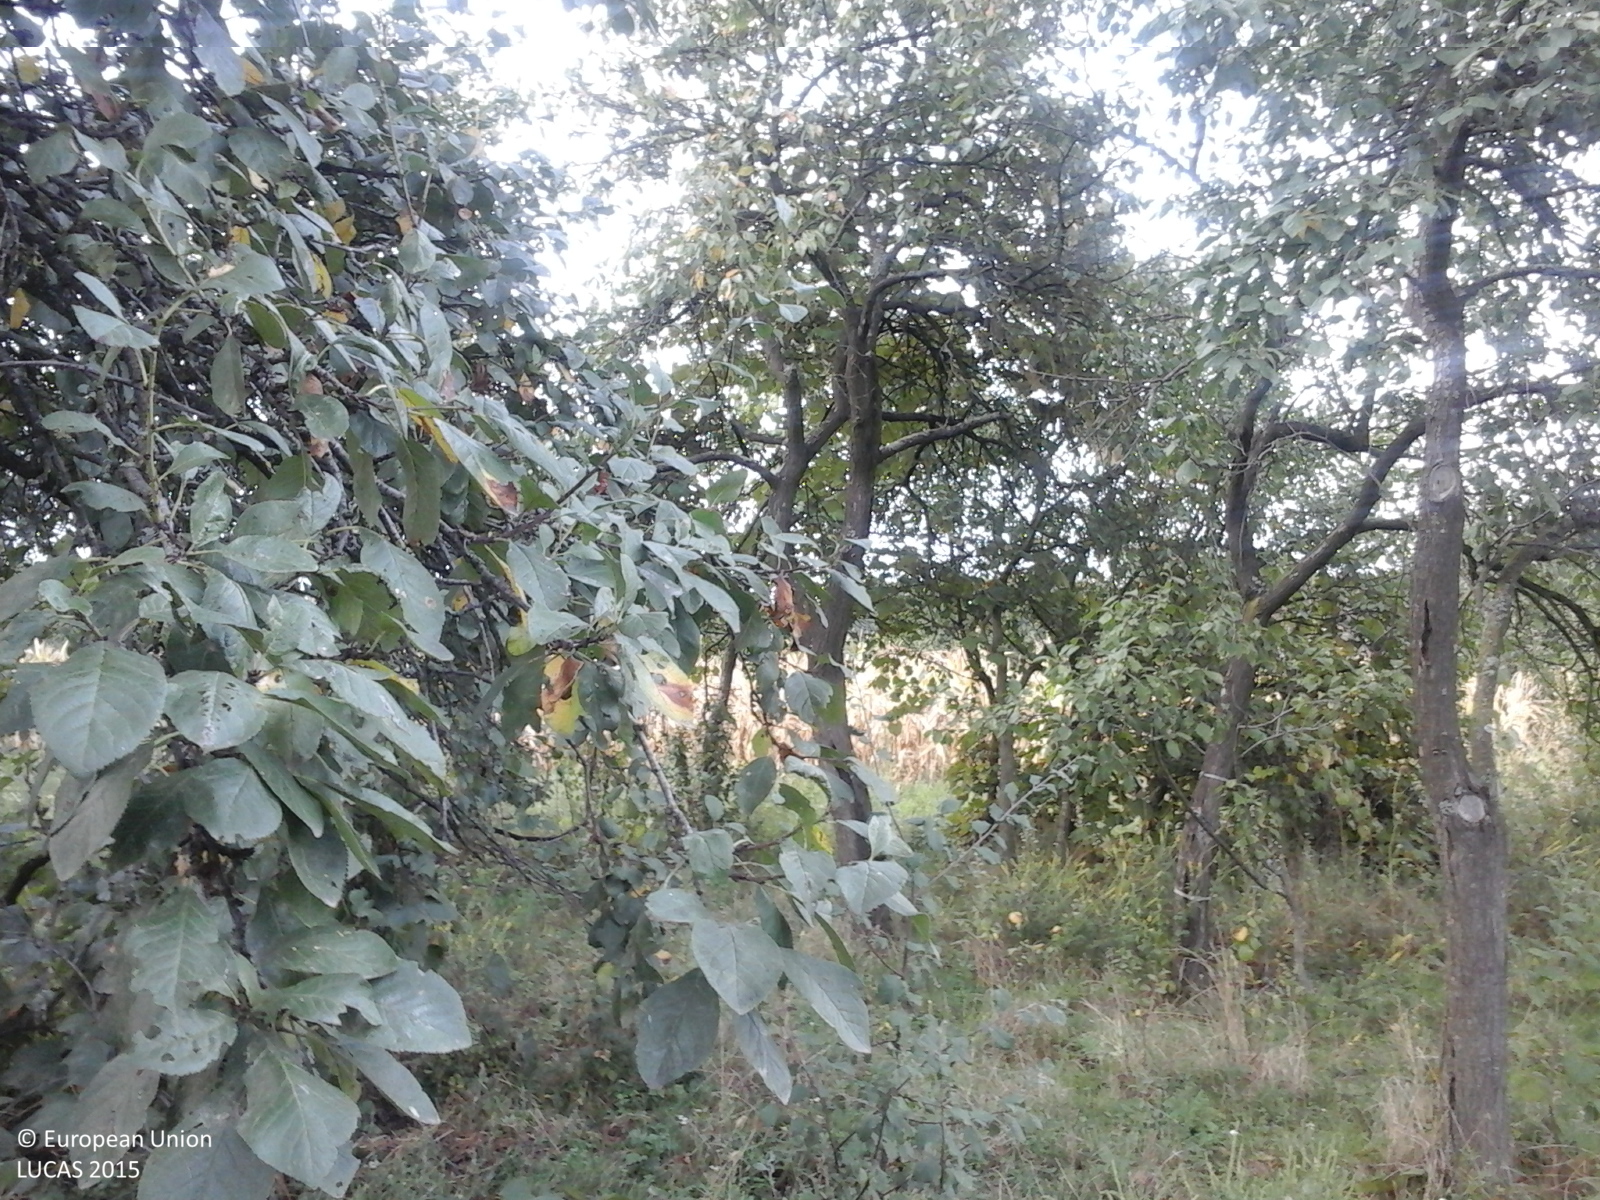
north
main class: Cropland
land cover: Other fruit trees and berries
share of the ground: > 75 %
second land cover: Grassland without tree/shrub cover
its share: > 75 %
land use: Agriculture (excluding fallow land and kitchen gardens)
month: September
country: RO
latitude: 47.4498
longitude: 22.5374
